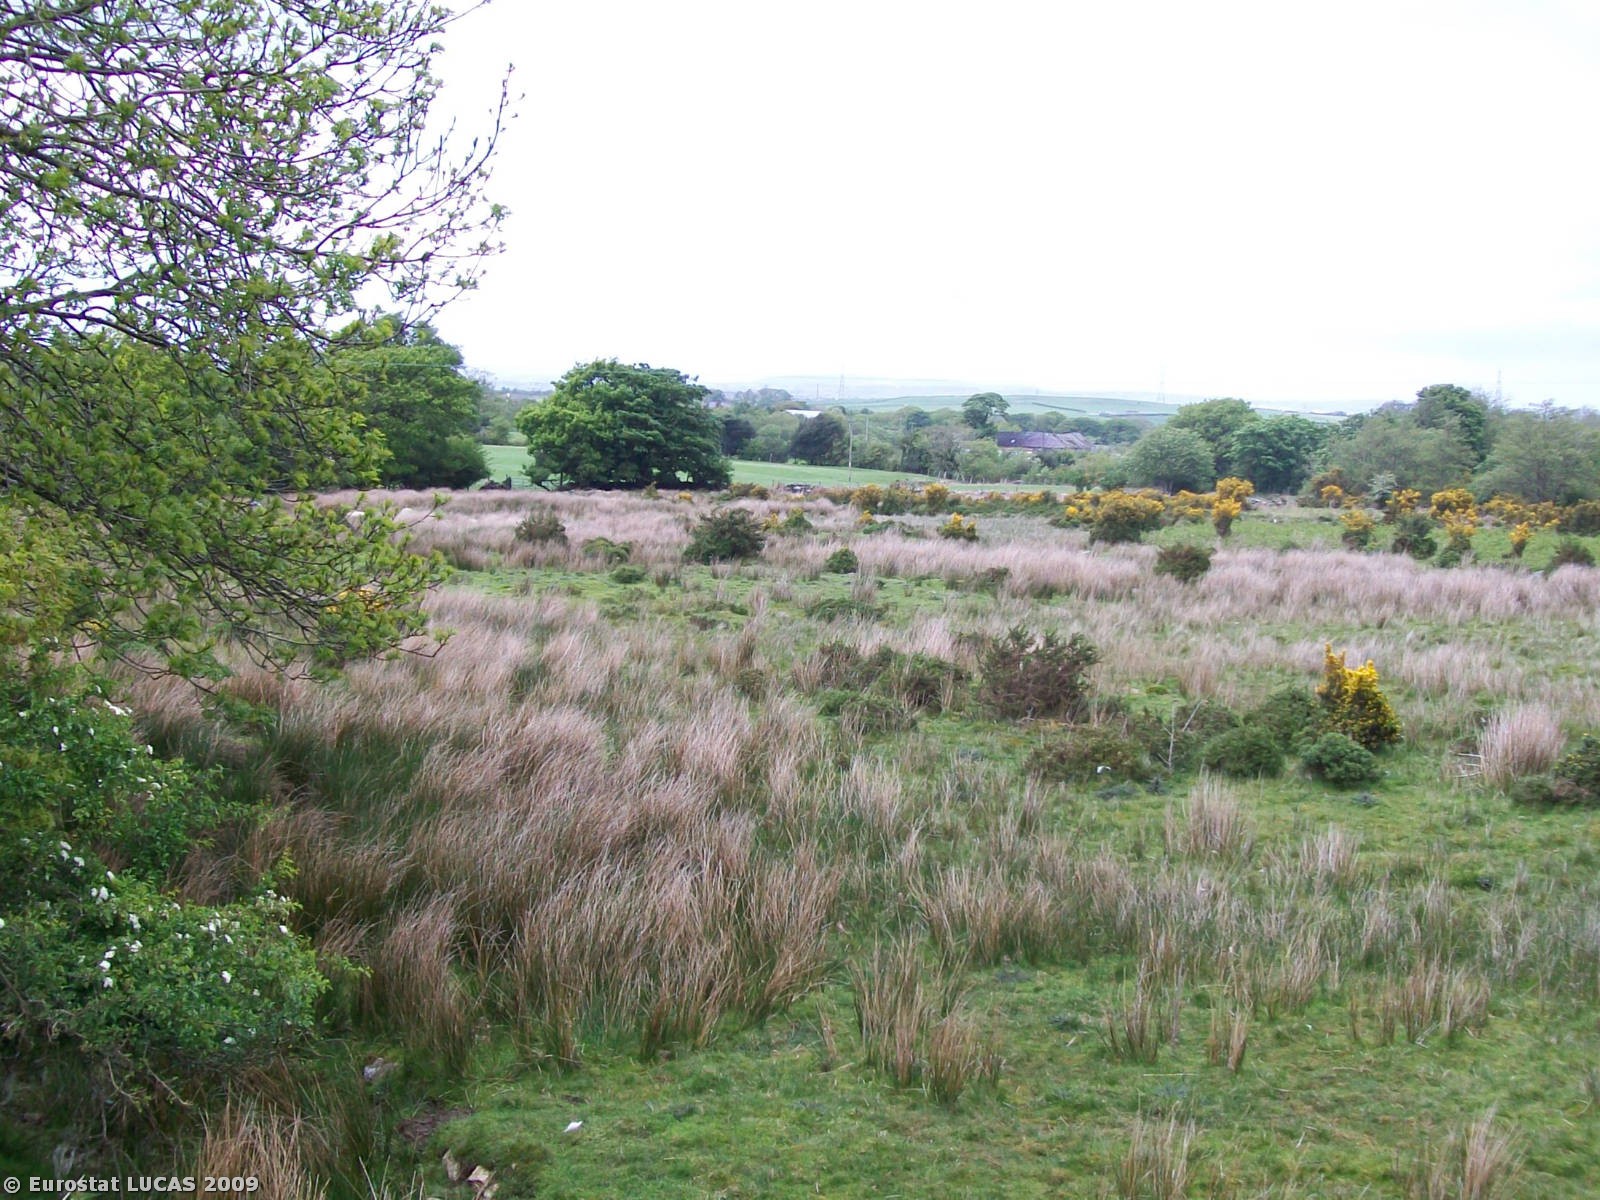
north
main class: Shrubland
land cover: Shrubland without tree cover
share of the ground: > 75 %
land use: Agriculture (excluding fallow land and kitchen gardens)
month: May
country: GB
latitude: 53.1689
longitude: -4.1438
